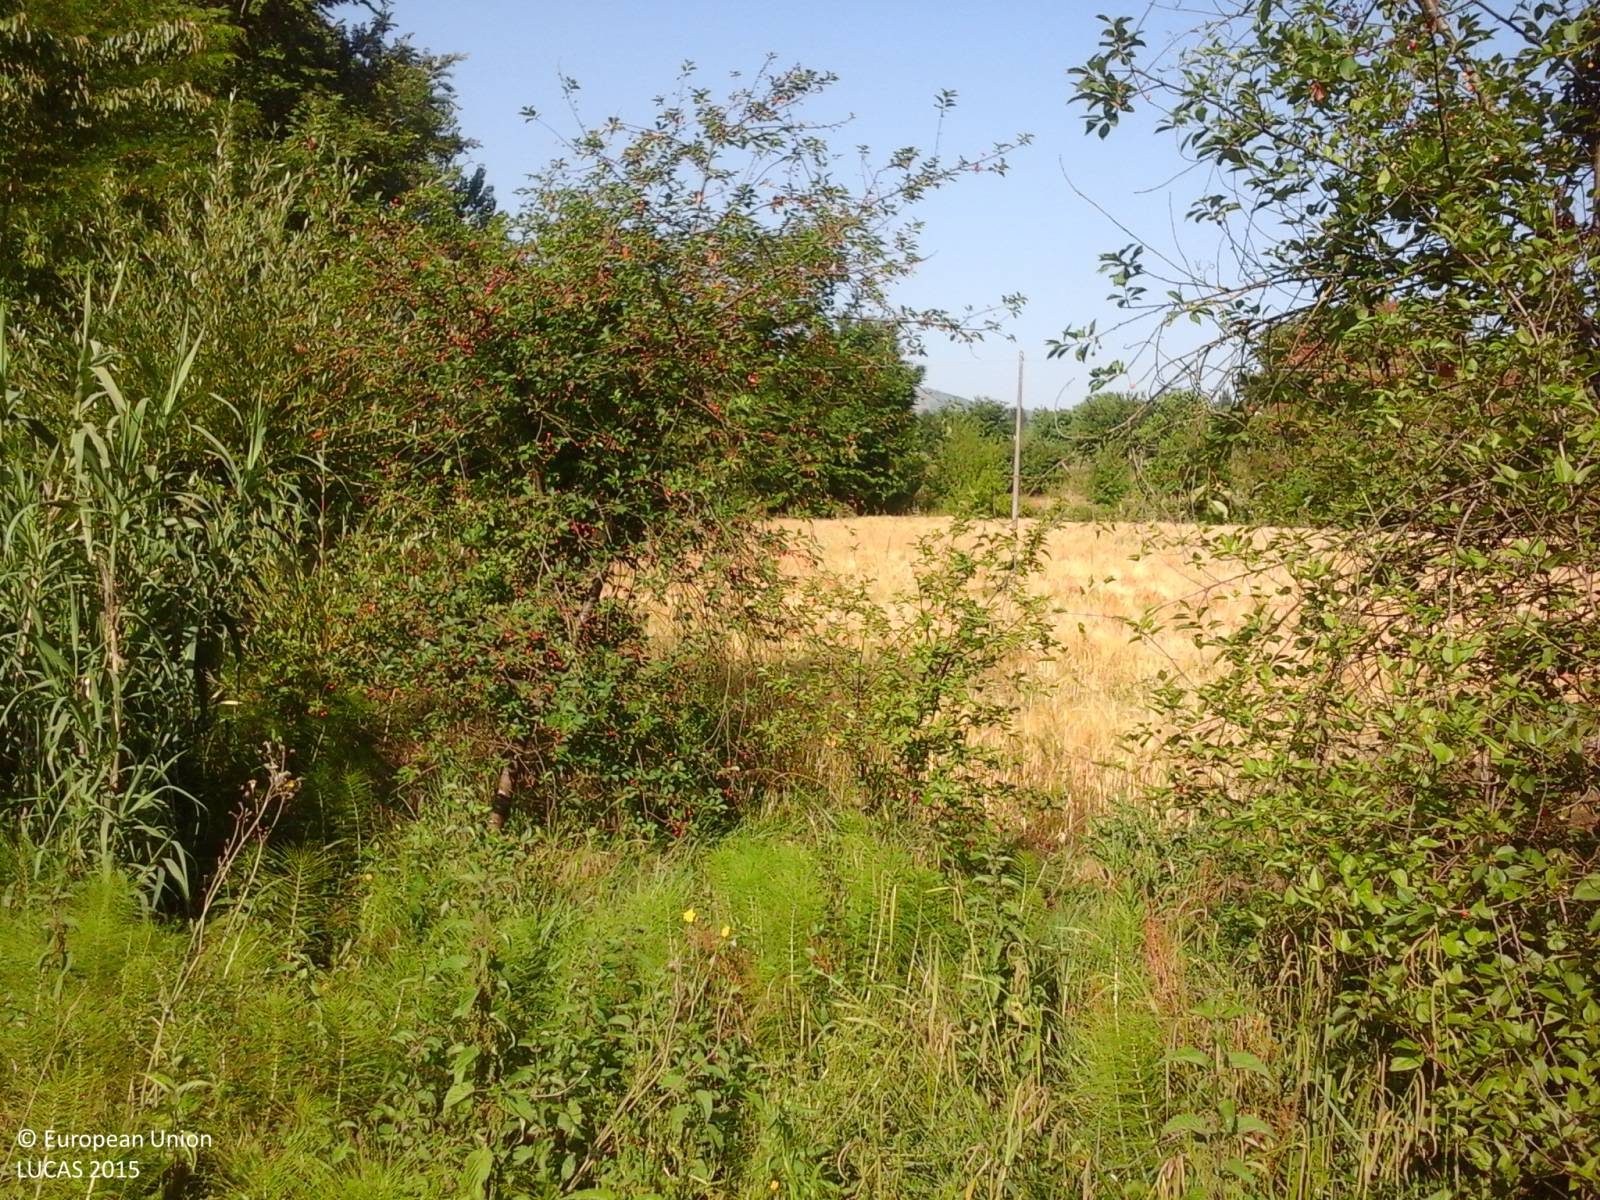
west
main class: Grassland
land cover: Spontaneously vegetated surfaces
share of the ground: > 75 %
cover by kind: herbaceous plants 100 %
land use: Agriculture (excluding fallow land and kitchen gardens)
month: June
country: IT
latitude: 41.0905
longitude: 14.4468
